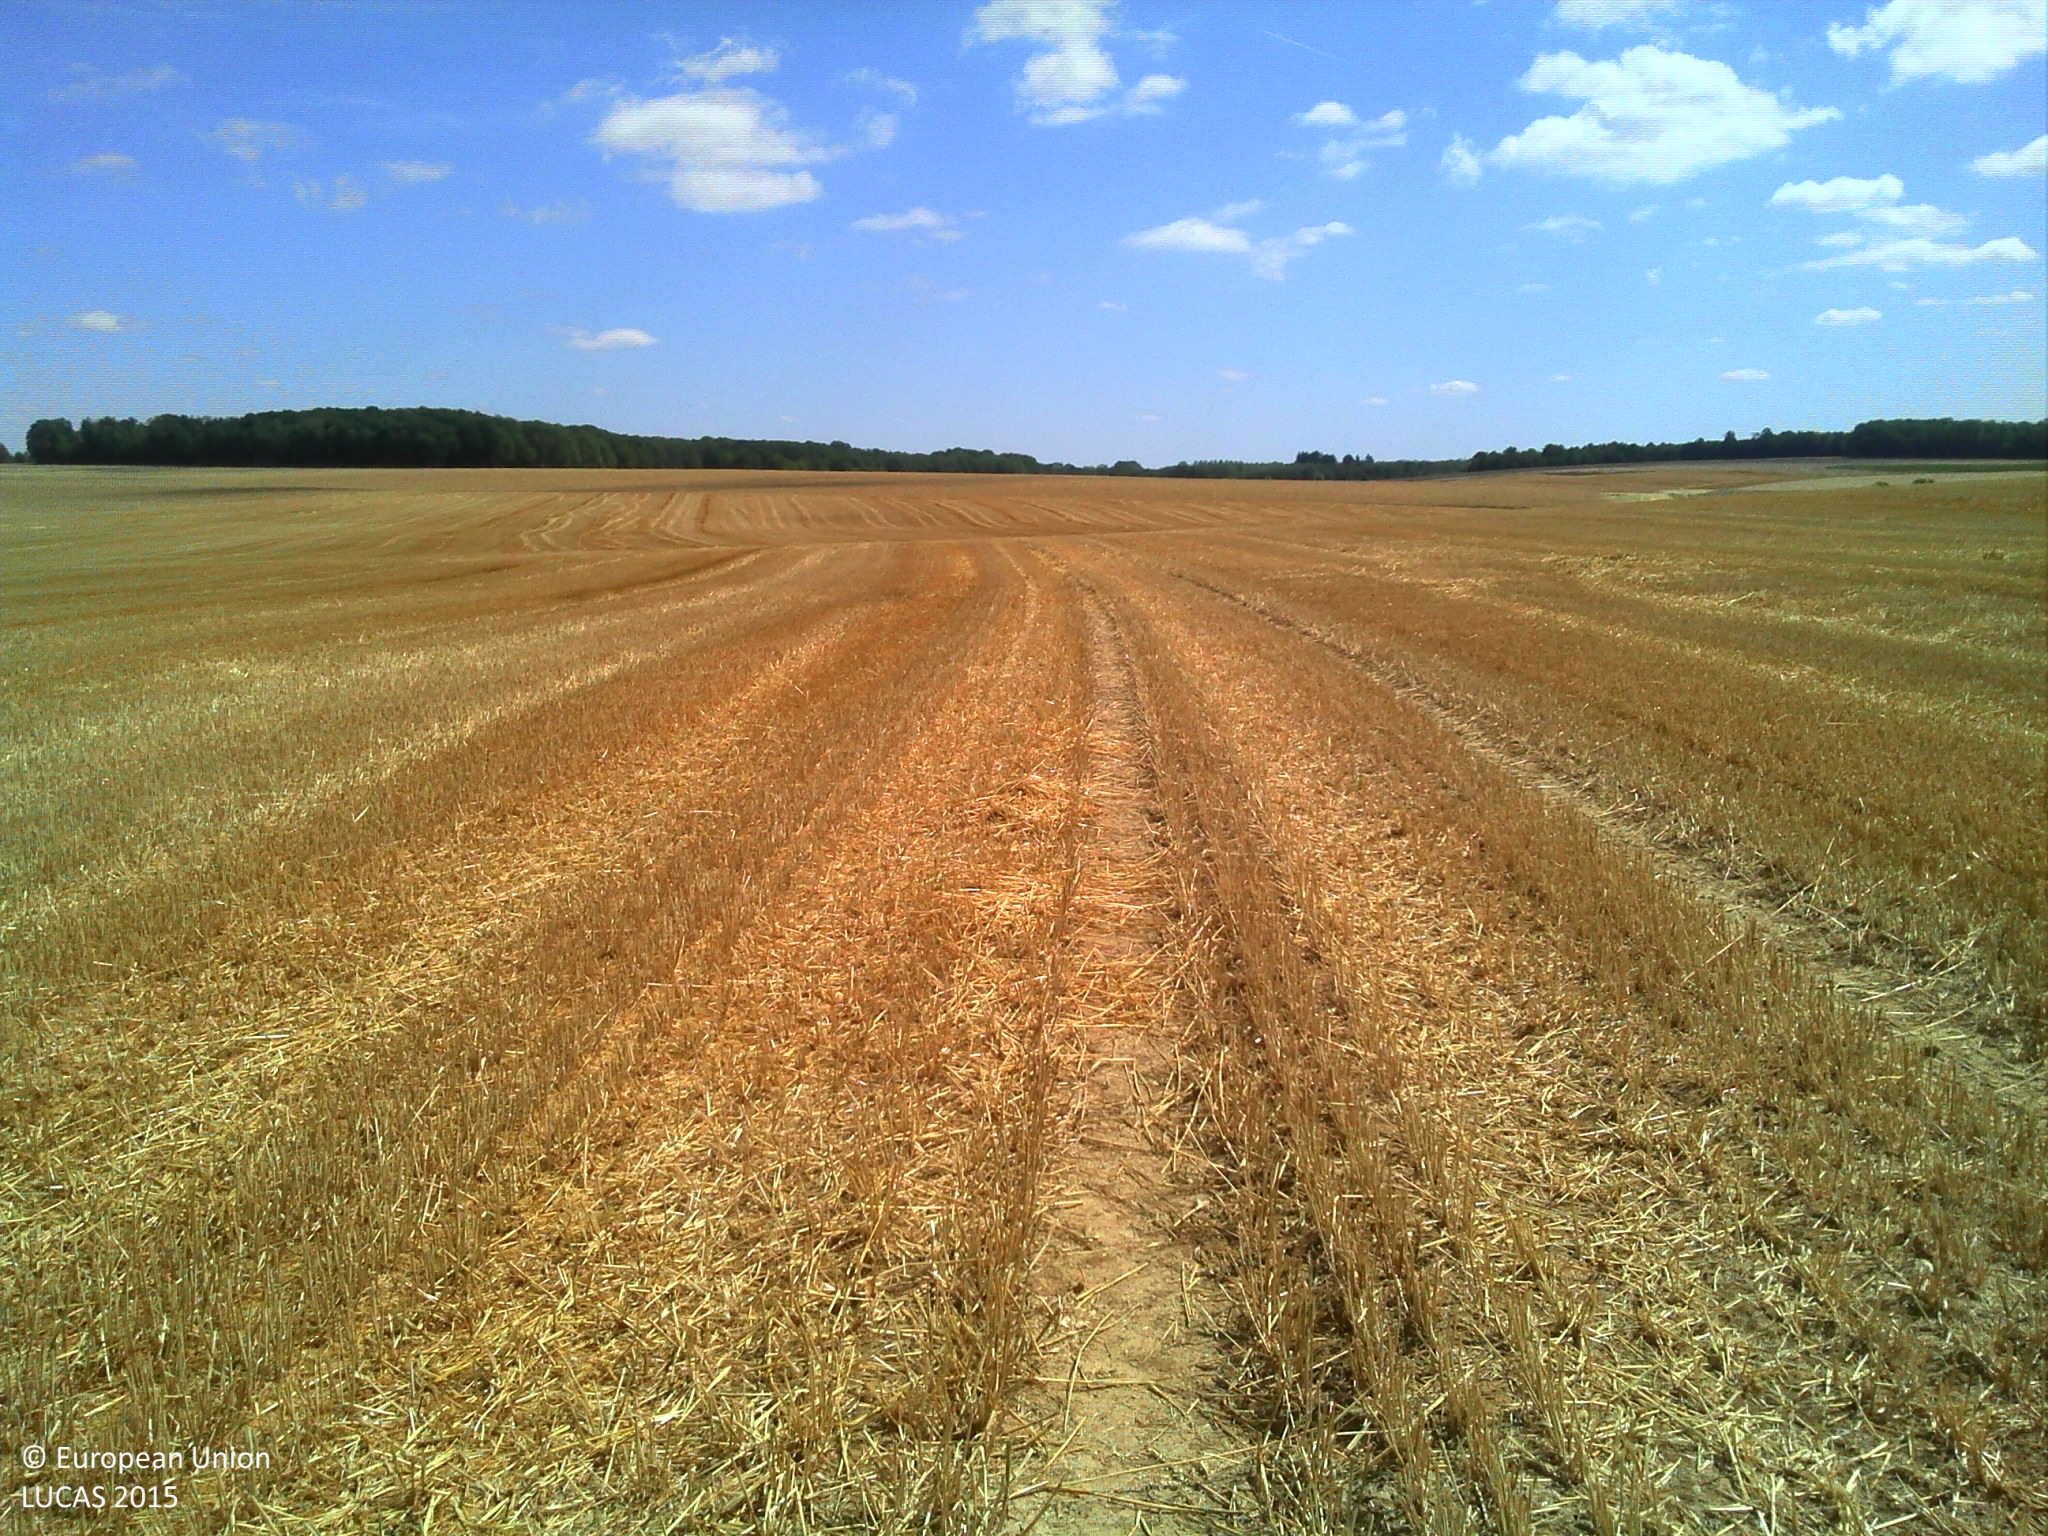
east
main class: Cropland
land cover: Durum wheat
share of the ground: 10 - 25 %
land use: Agriculture (excluding fallow land and kitchen gardens)
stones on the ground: 10 - 25 %
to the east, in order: Durum wheat
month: August
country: FR
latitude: 48.7134
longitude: 3.4290
